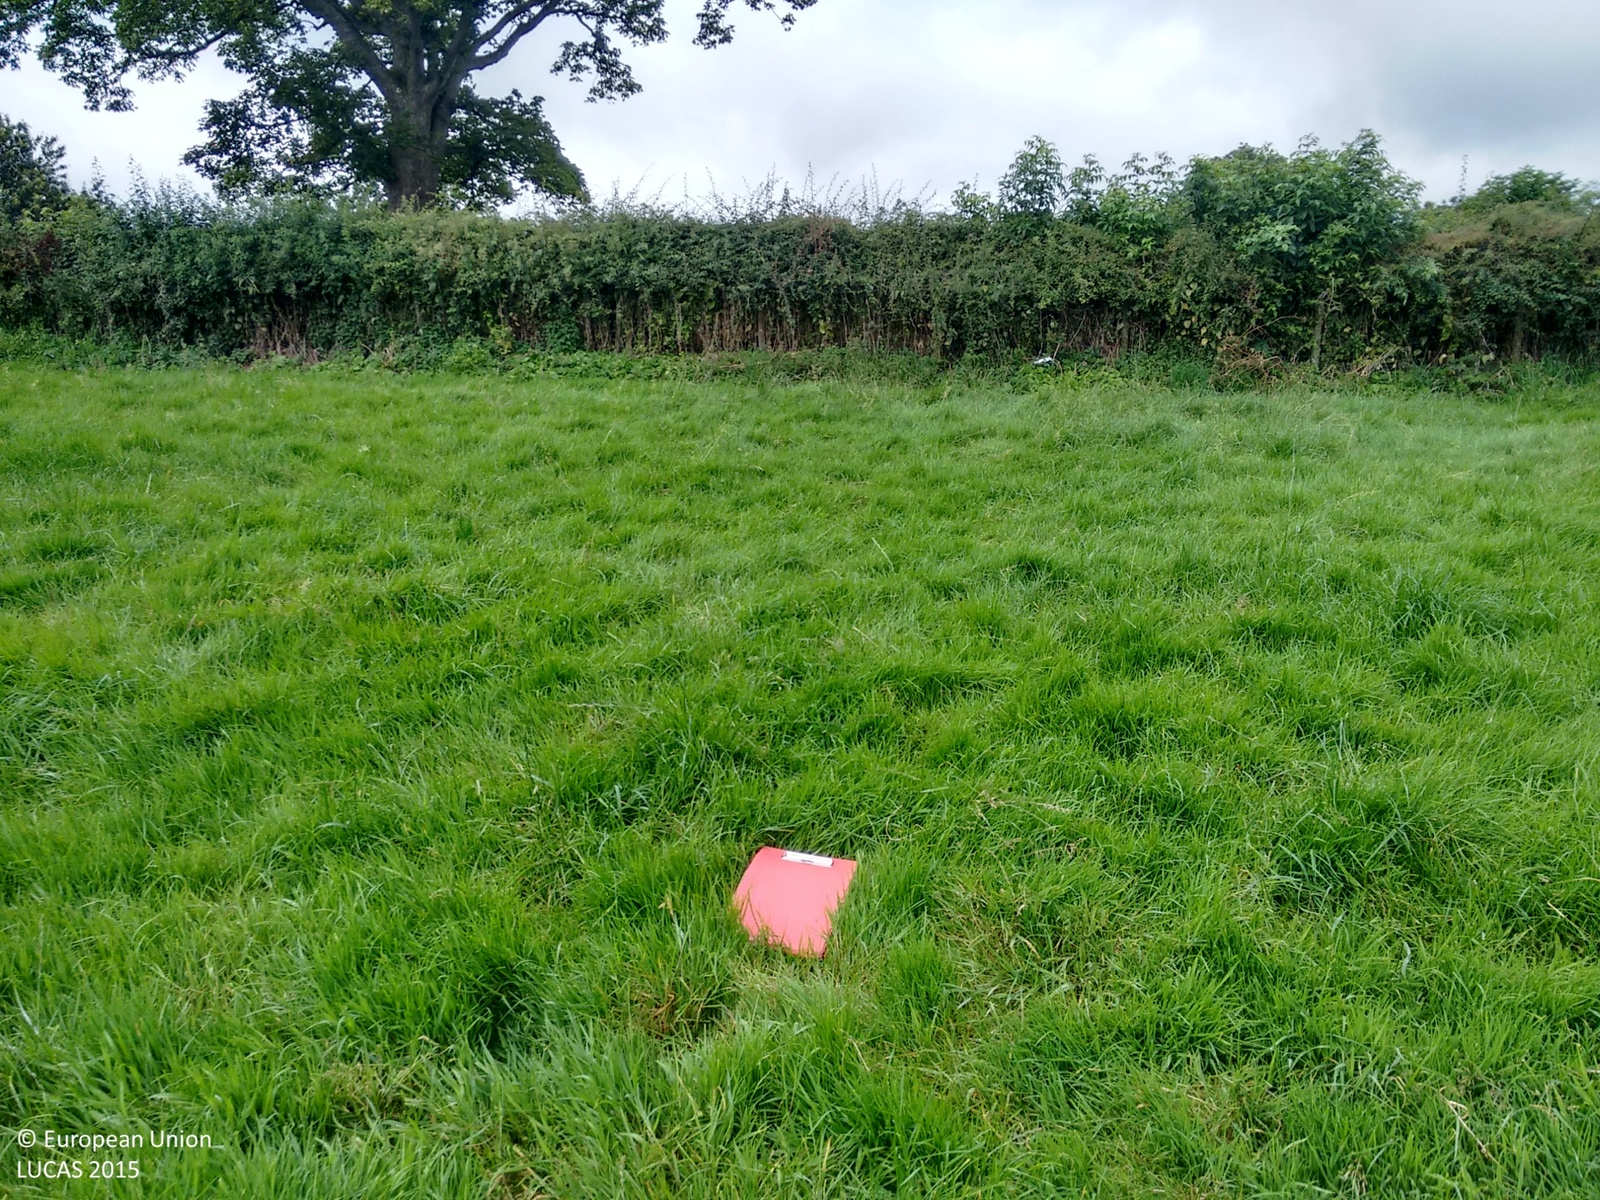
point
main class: Grassland
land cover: Grassland without tree/shrub cover
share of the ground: > 75 %
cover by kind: herbaceous plants 100 %
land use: Agriculture (excluding fallow land and kitchen gardens)
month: August
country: GB
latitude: 54.7152
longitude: -2.8763
